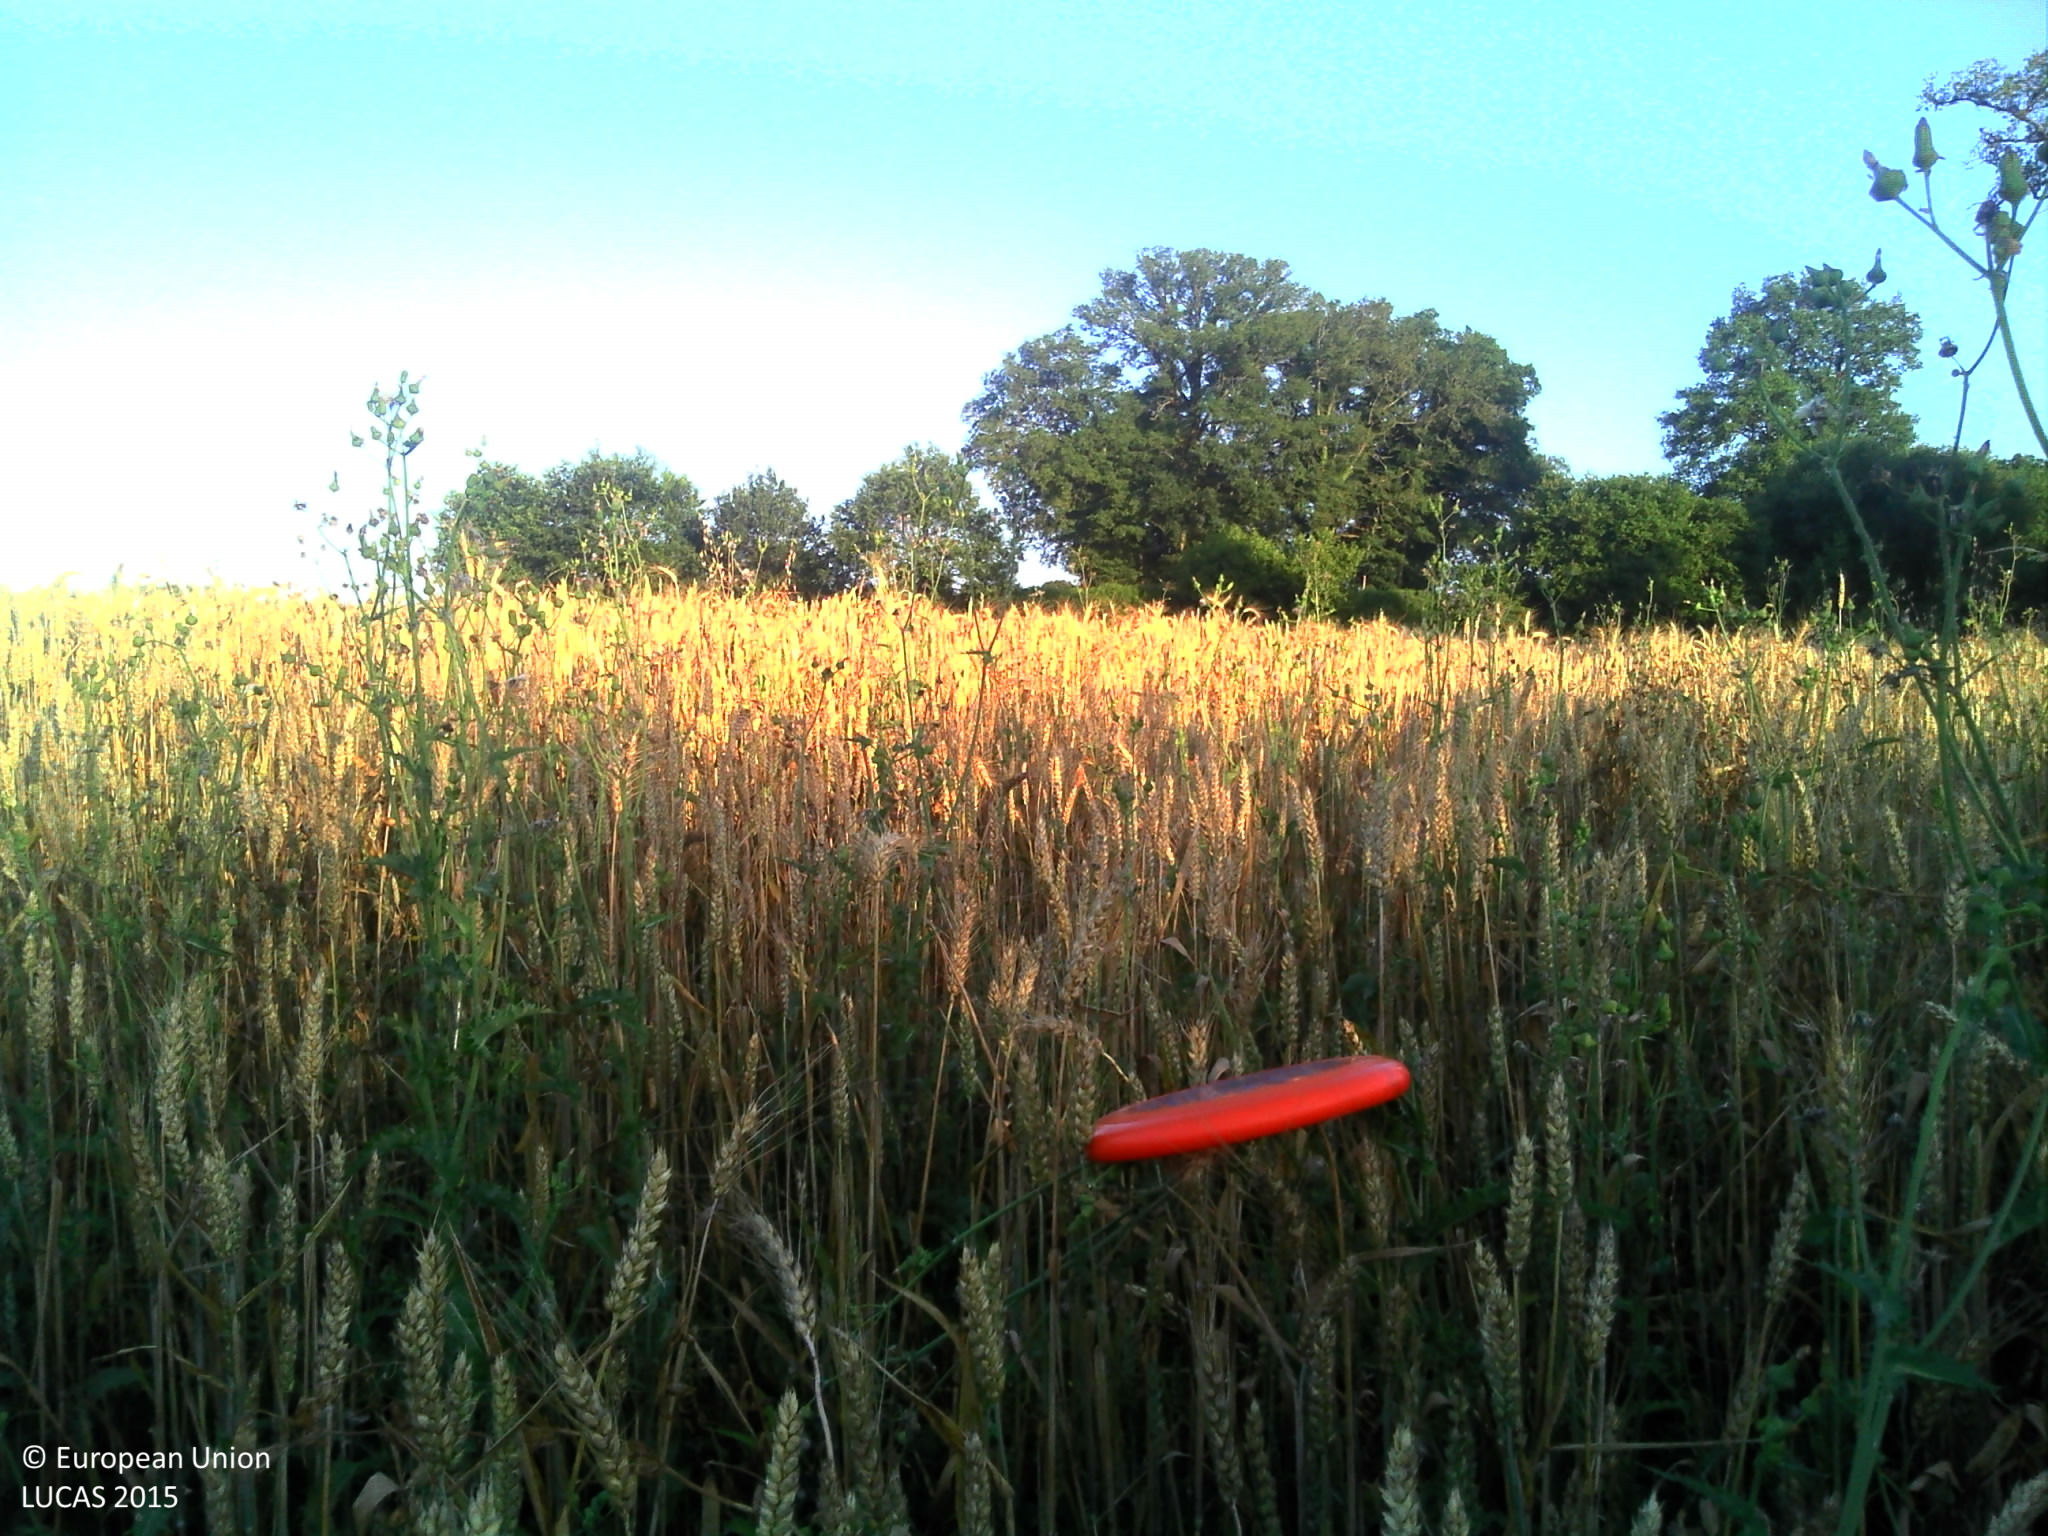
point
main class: Cropland
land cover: Common wheat
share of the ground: > 75 %
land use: Agriculture (excluding fallow land and kitchen gardens)
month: July
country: FR
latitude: 46.0848
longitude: 1.7289
